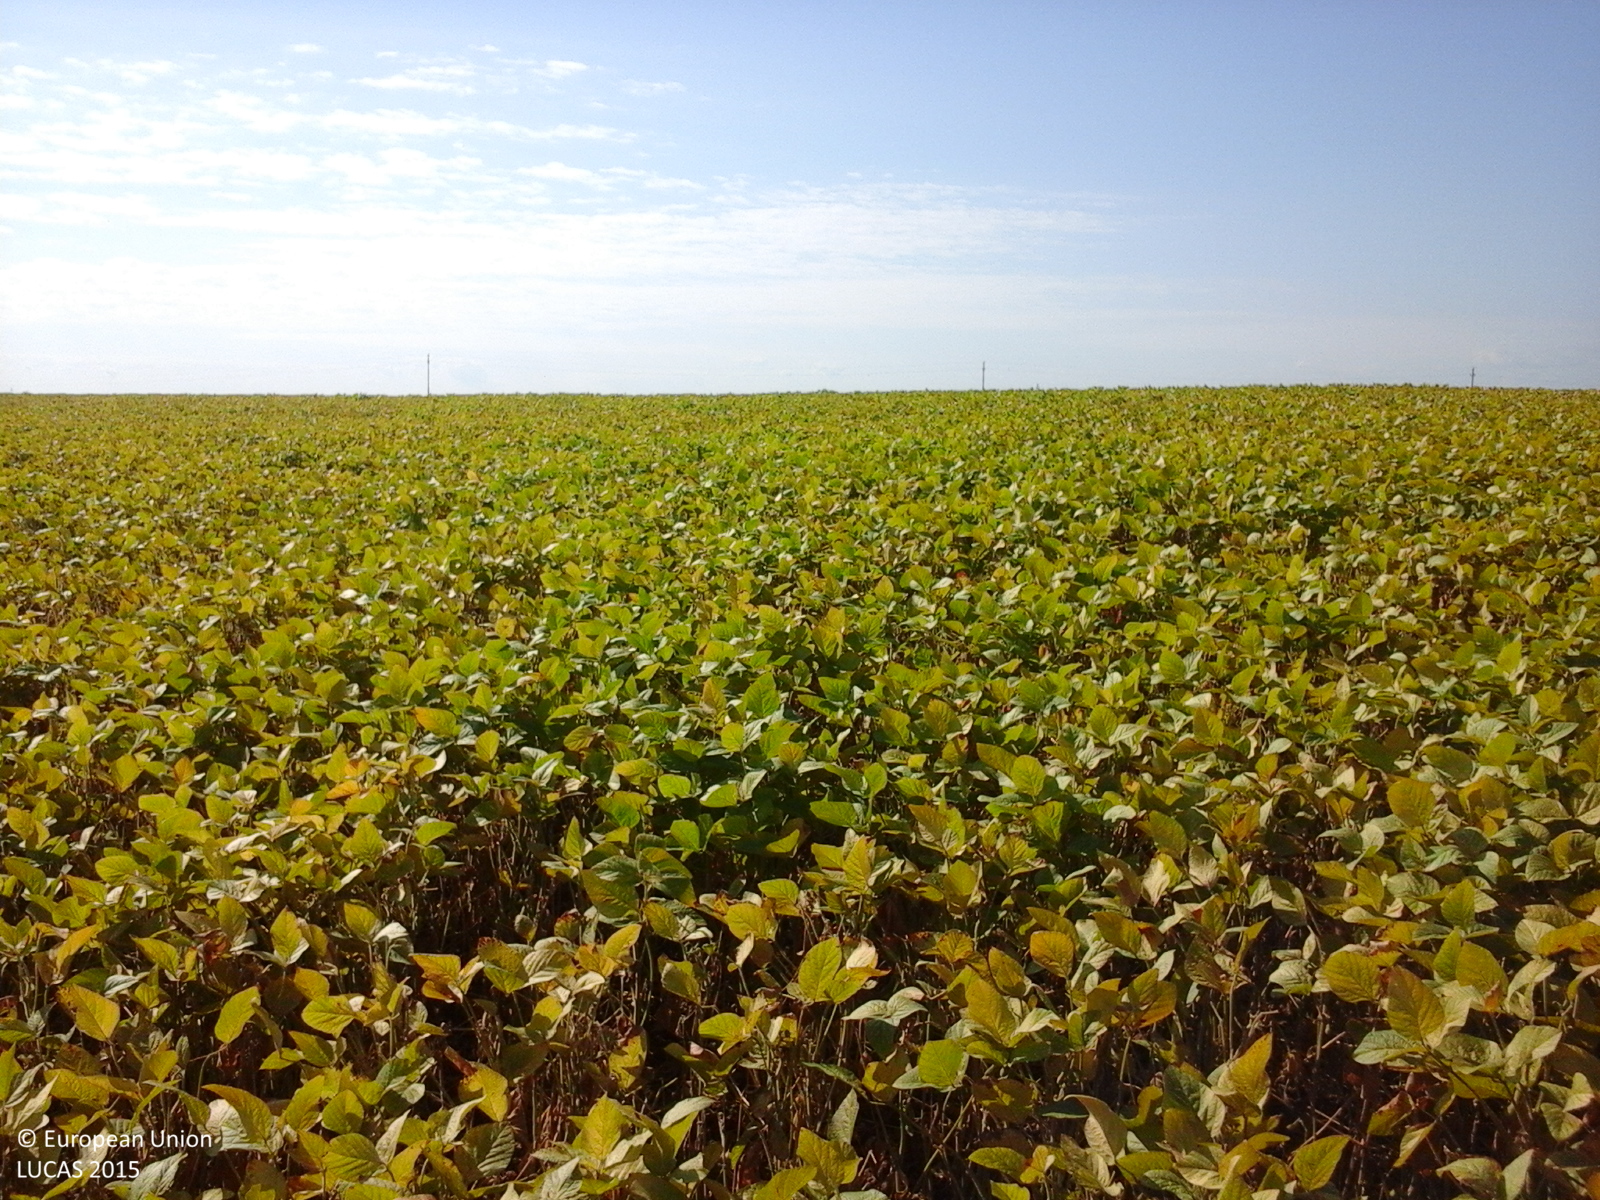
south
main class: Cropland
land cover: Soya
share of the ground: > 75 %
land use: Agriculture (excluding fallow land and kitchen gardens)
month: September
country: RO
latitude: 47.5138
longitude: 22.7690
